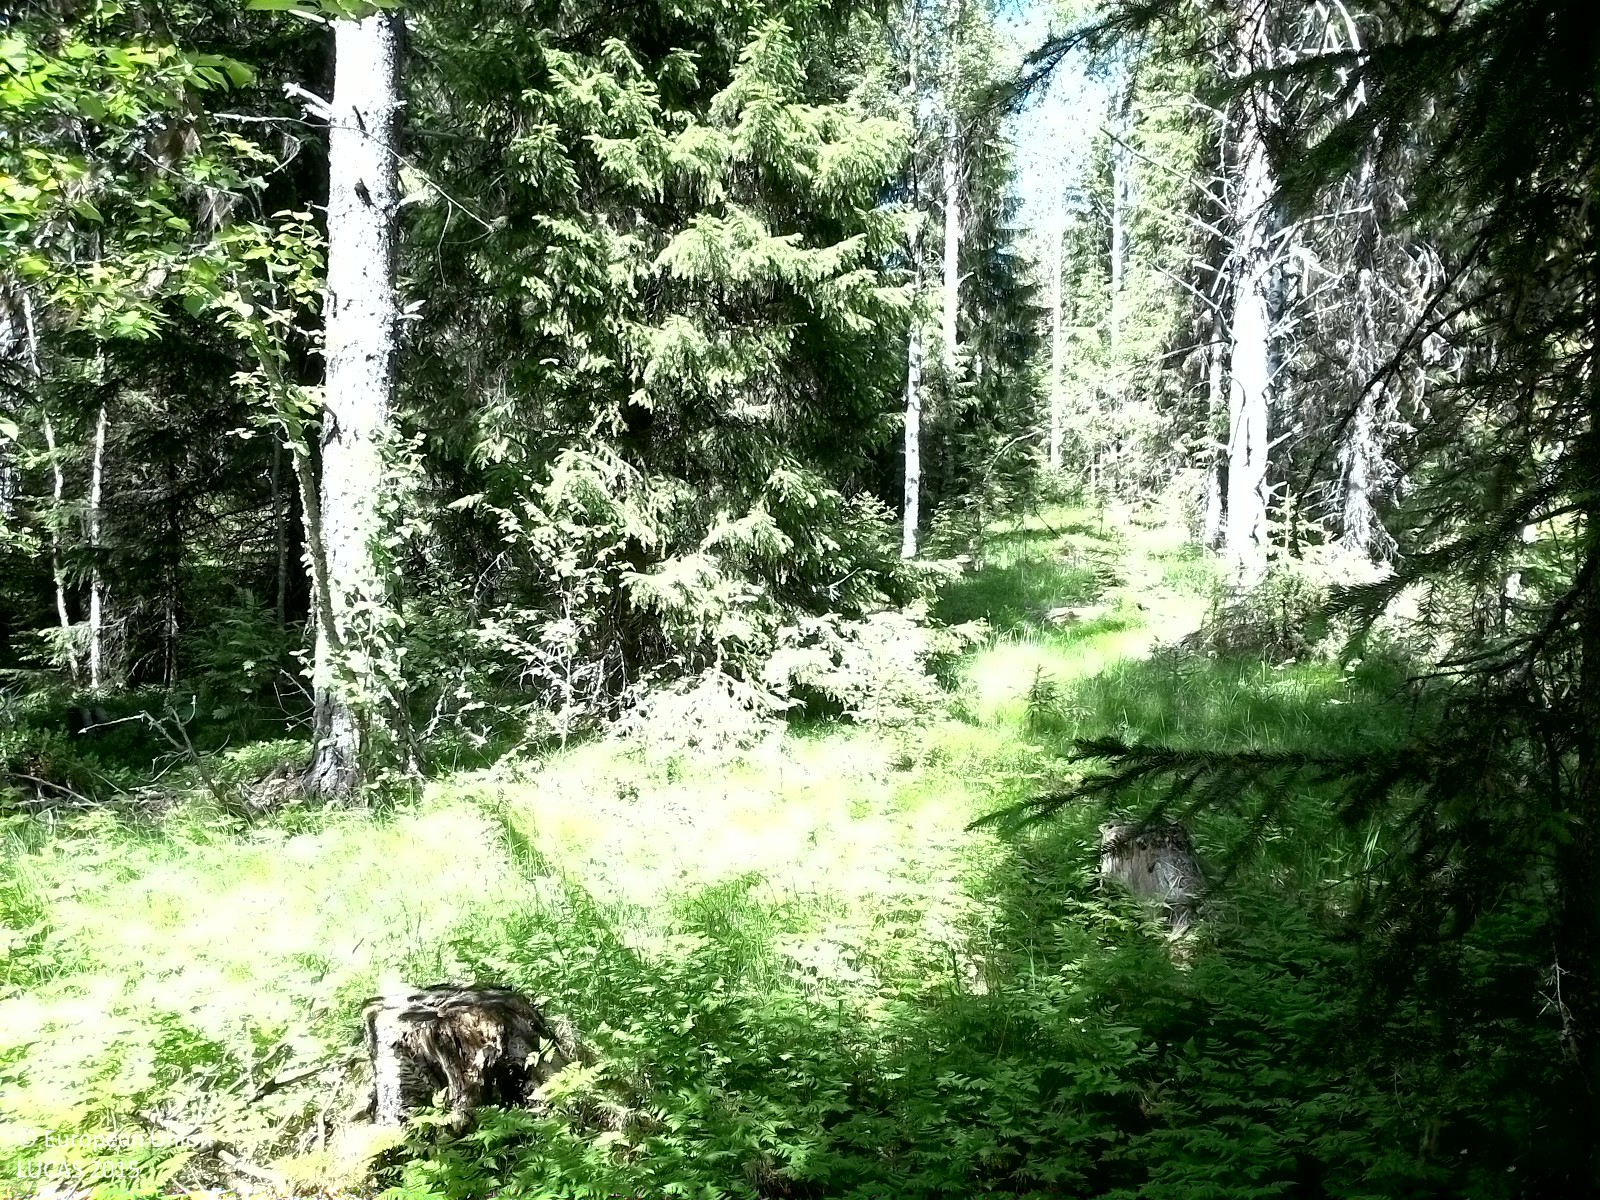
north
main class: Woodland
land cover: Other mixed woodland
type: boreal forest
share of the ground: 25 - 50 %
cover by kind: broadleaved forest trees 30 %, herbaceous plants 30 %, coniferous forest trees 20 %, lichens and mosses 20 %
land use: Forestry
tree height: > 5 m
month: July
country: SE
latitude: 62.1530
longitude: 16.7552
